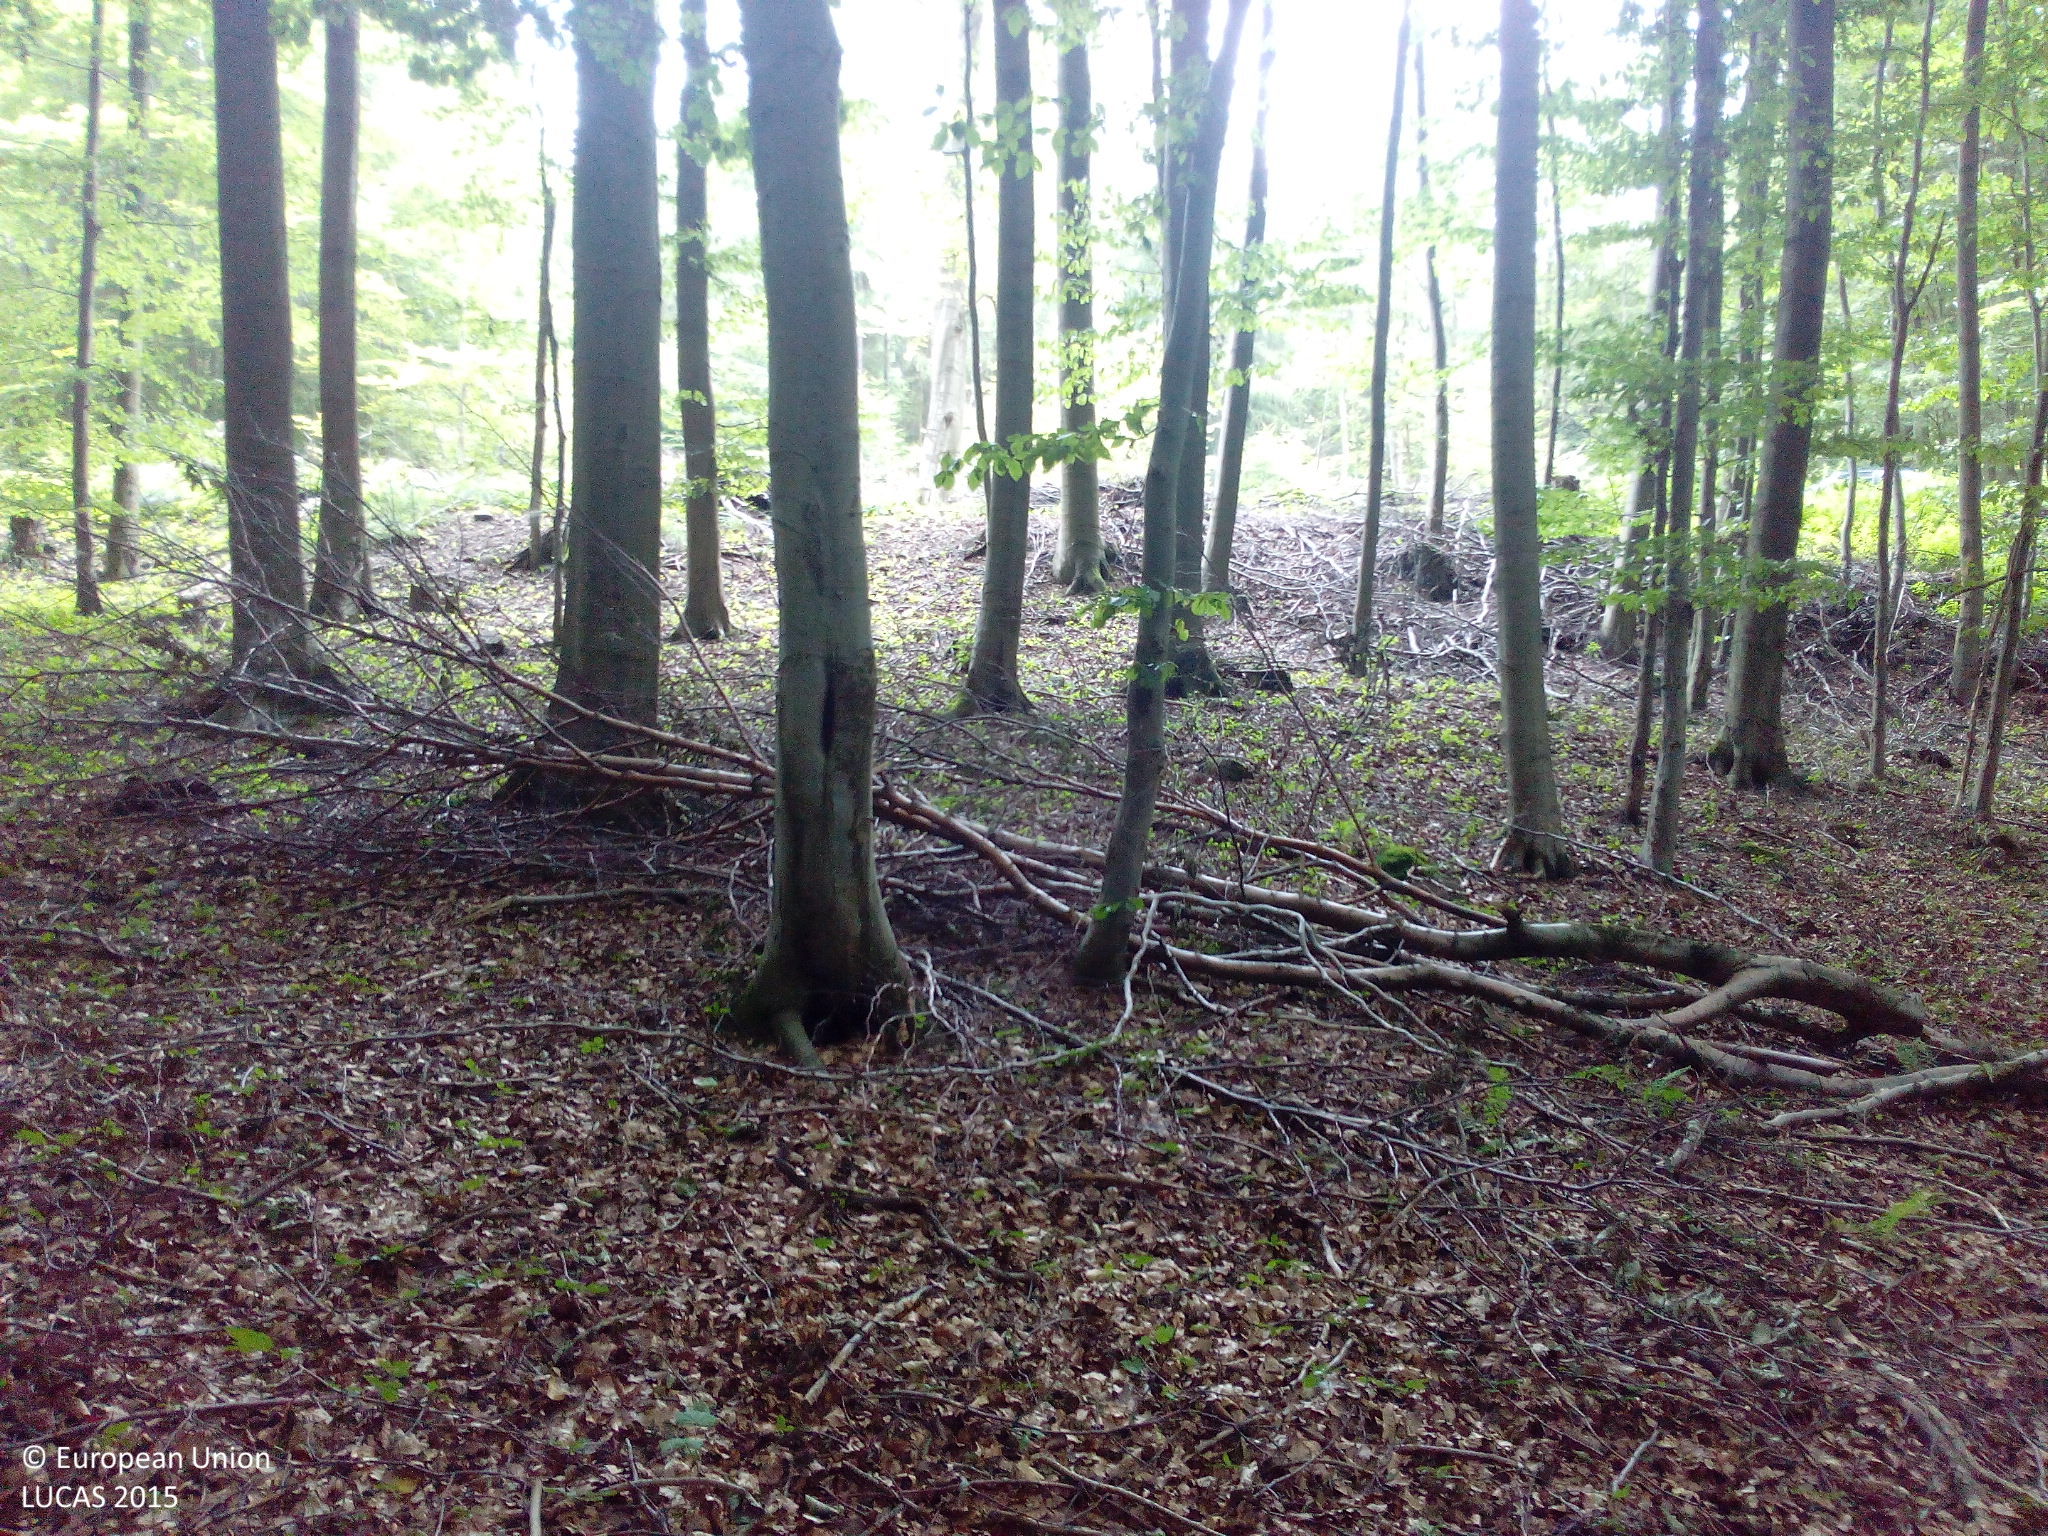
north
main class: Woodland
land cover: Broadleaved woodland
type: beech forest
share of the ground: > 75 %
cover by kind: broadleaved forest trees 95 %, herbaceous plants 5 %
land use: Forestry
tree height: > 5 m
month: August
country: DE
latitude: 51.8896
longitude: 9.2302
